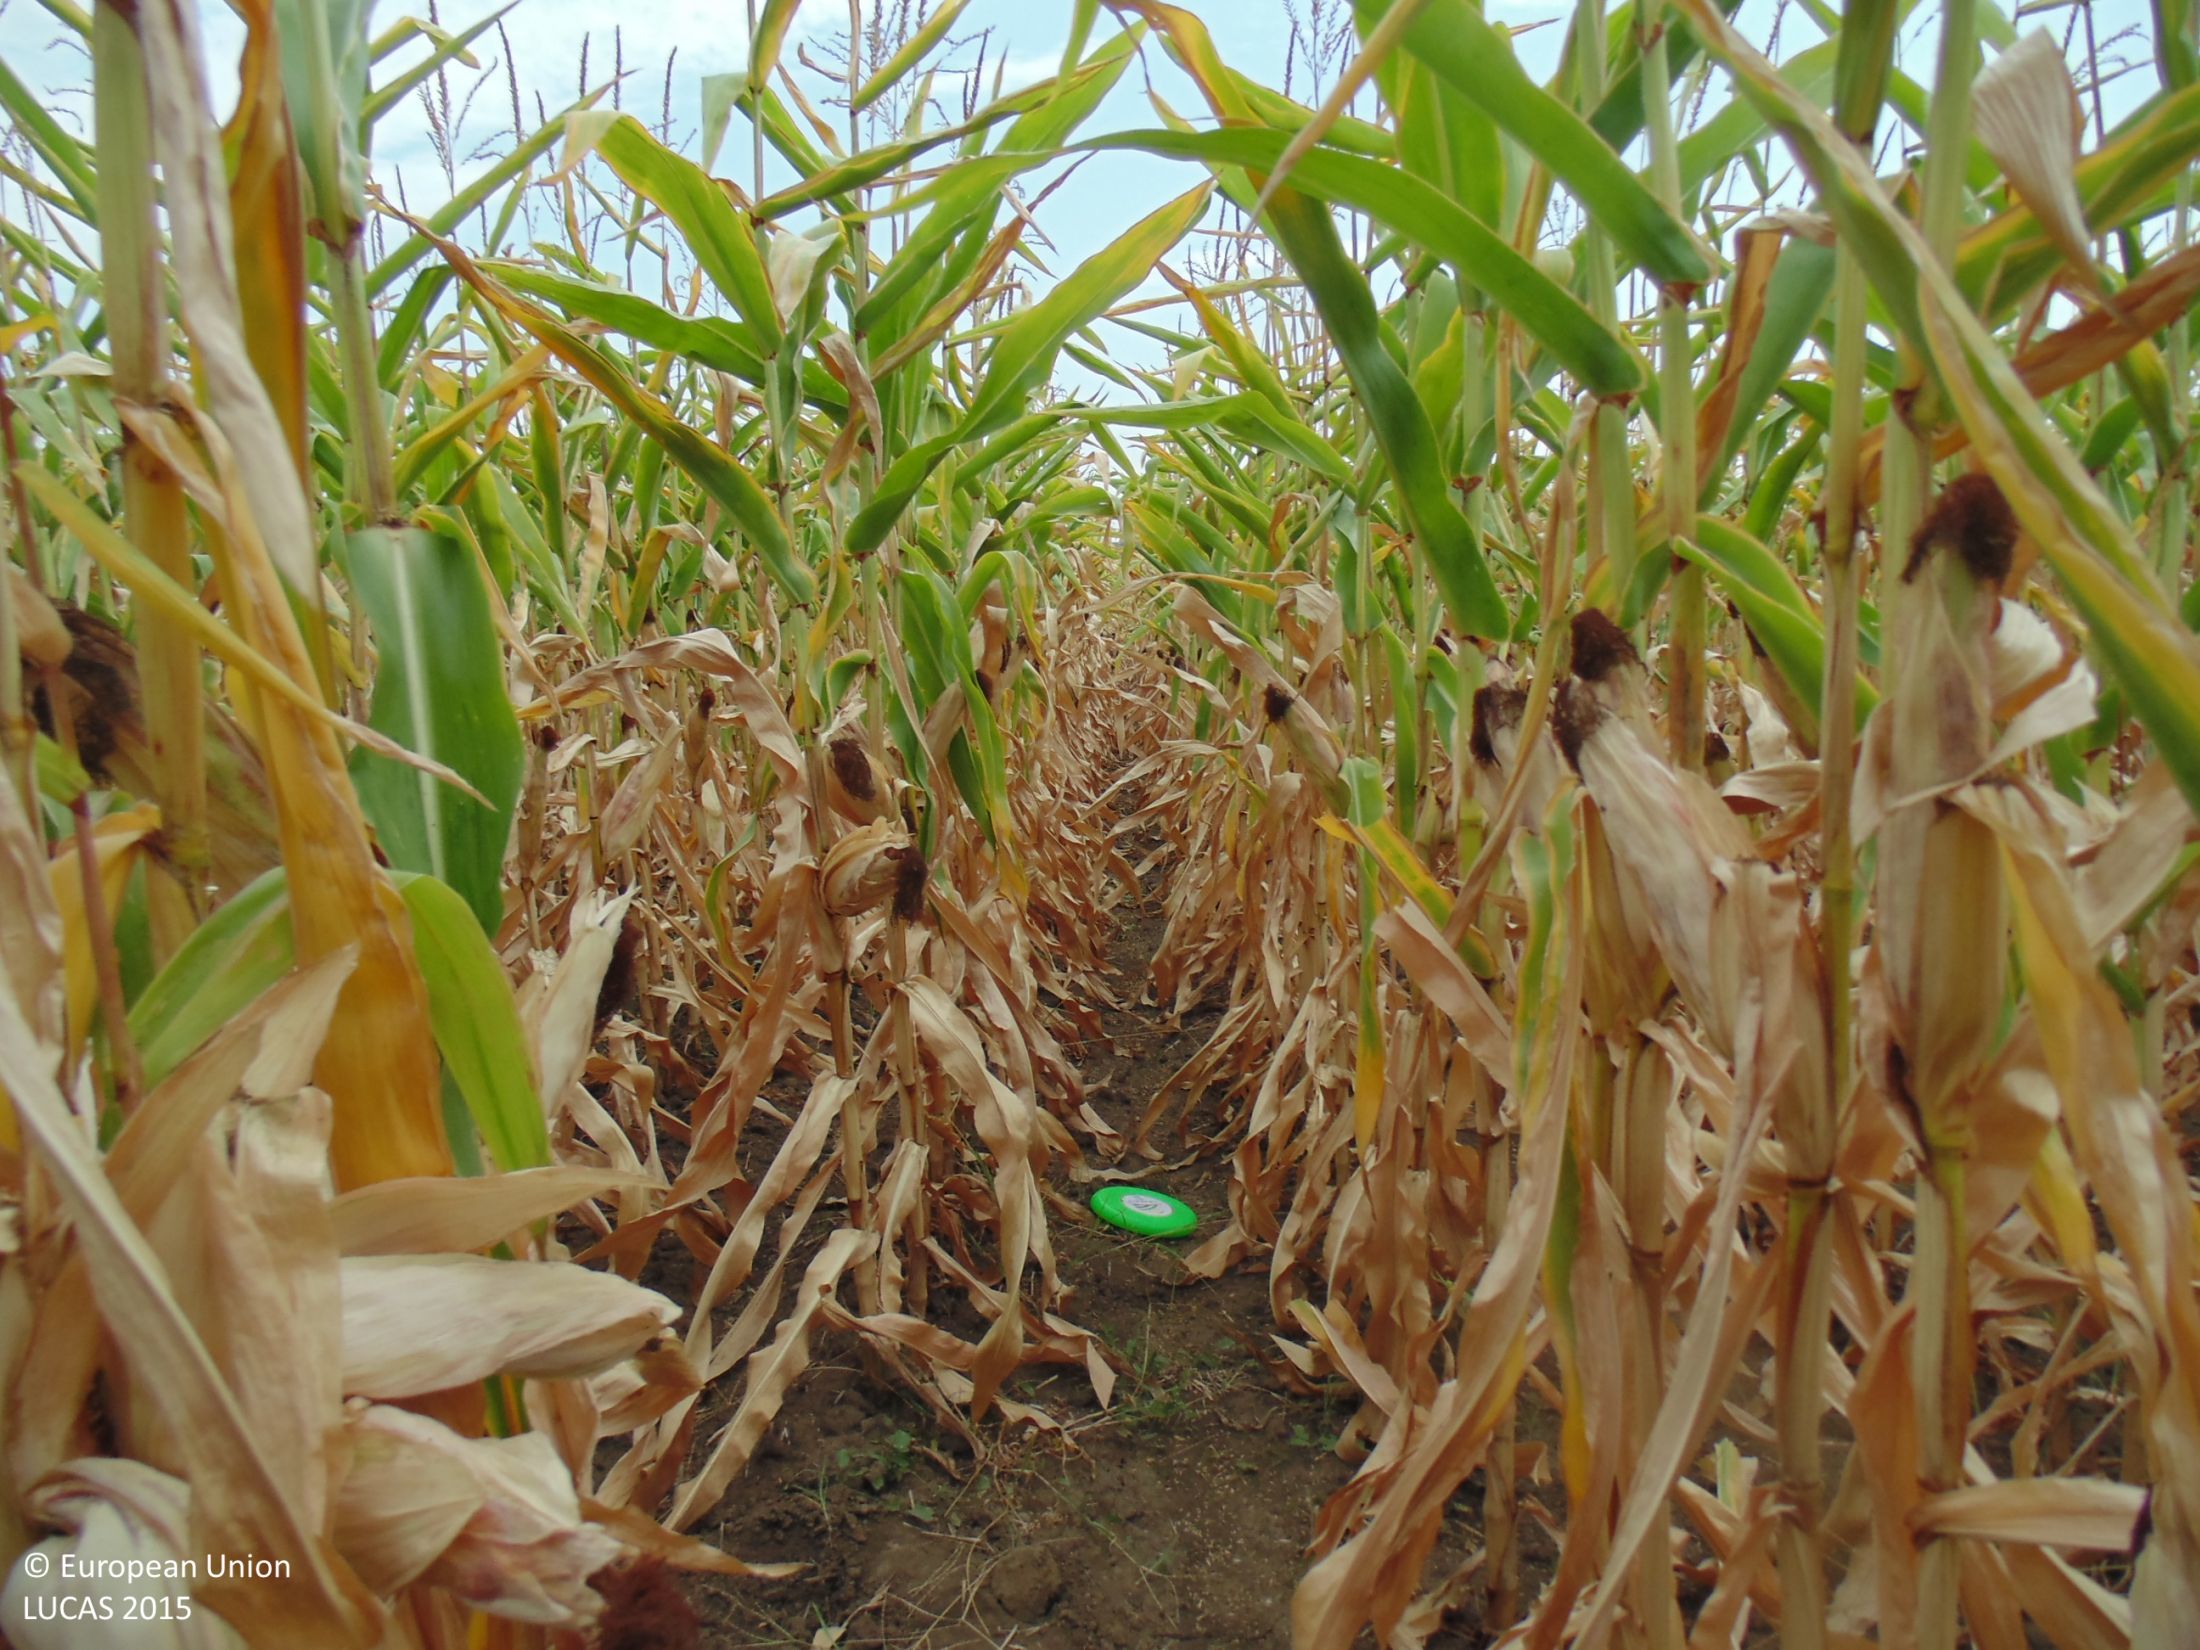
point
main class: Cropland
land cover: Maize
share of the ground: > 75 %
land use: Agriculture (excluding fallow land and kitchen gardens)
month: August
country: BG
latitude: 43.9439
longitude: 27.7741
